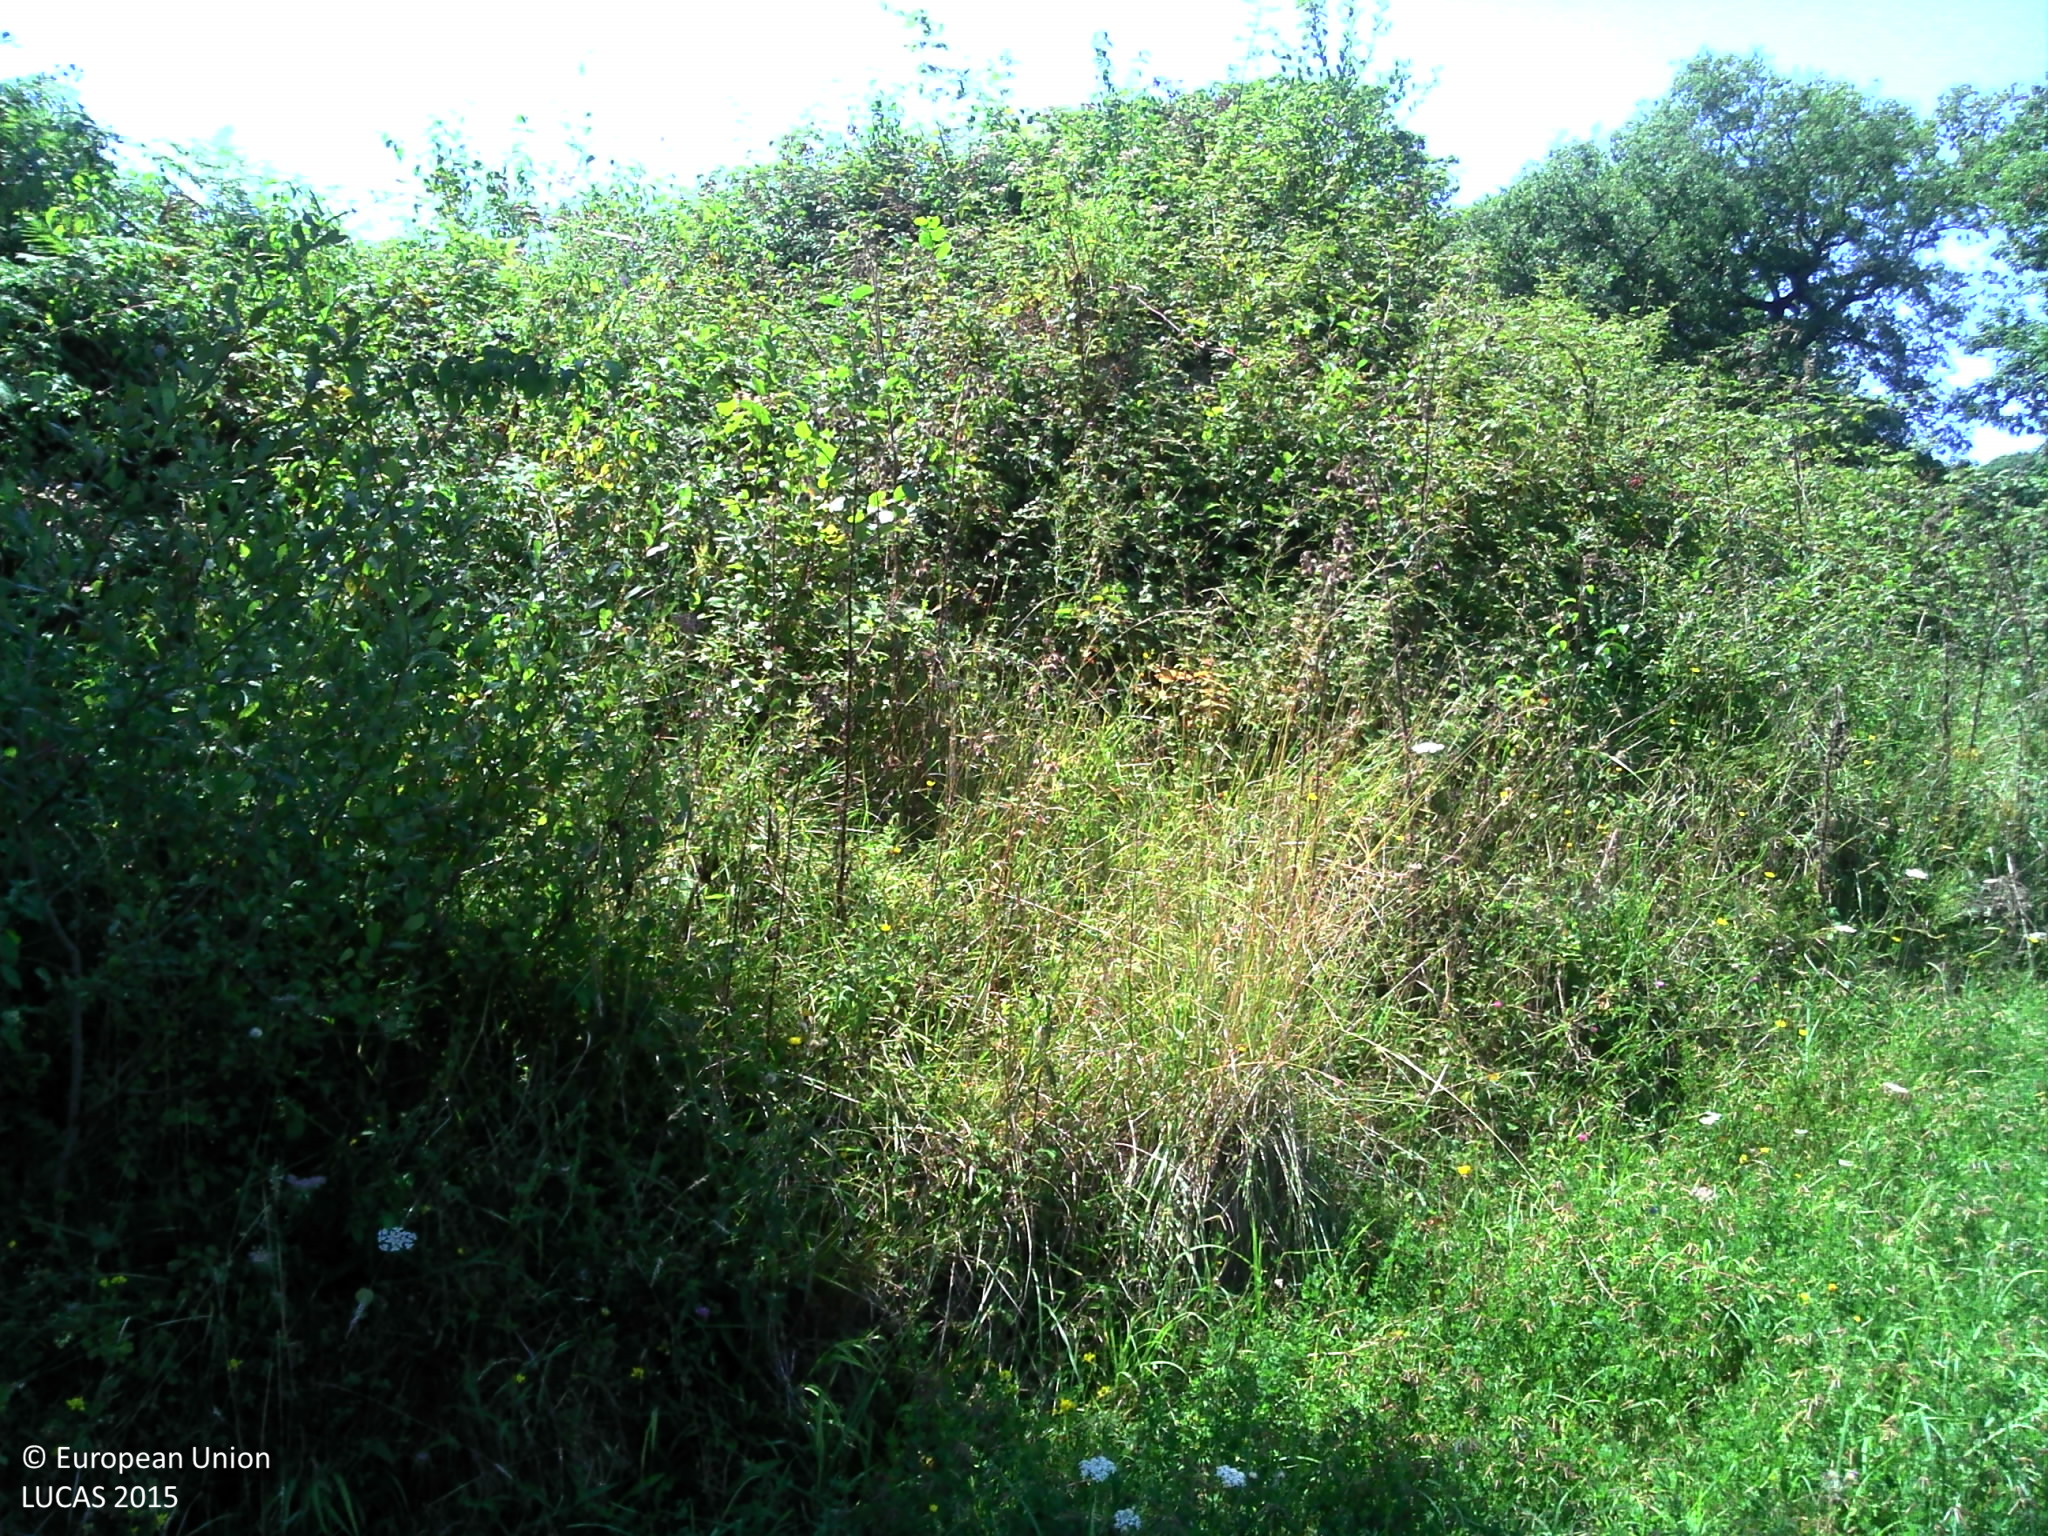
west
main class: Cropland
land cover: Temporary grasslands
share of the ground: > 75 %
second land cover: Lucerne
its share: 10 - 25 %
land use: Agriculture (excluding fallow land and kitchen gardens)
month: August
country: FR
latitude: 43.3167
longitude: -1.0981
